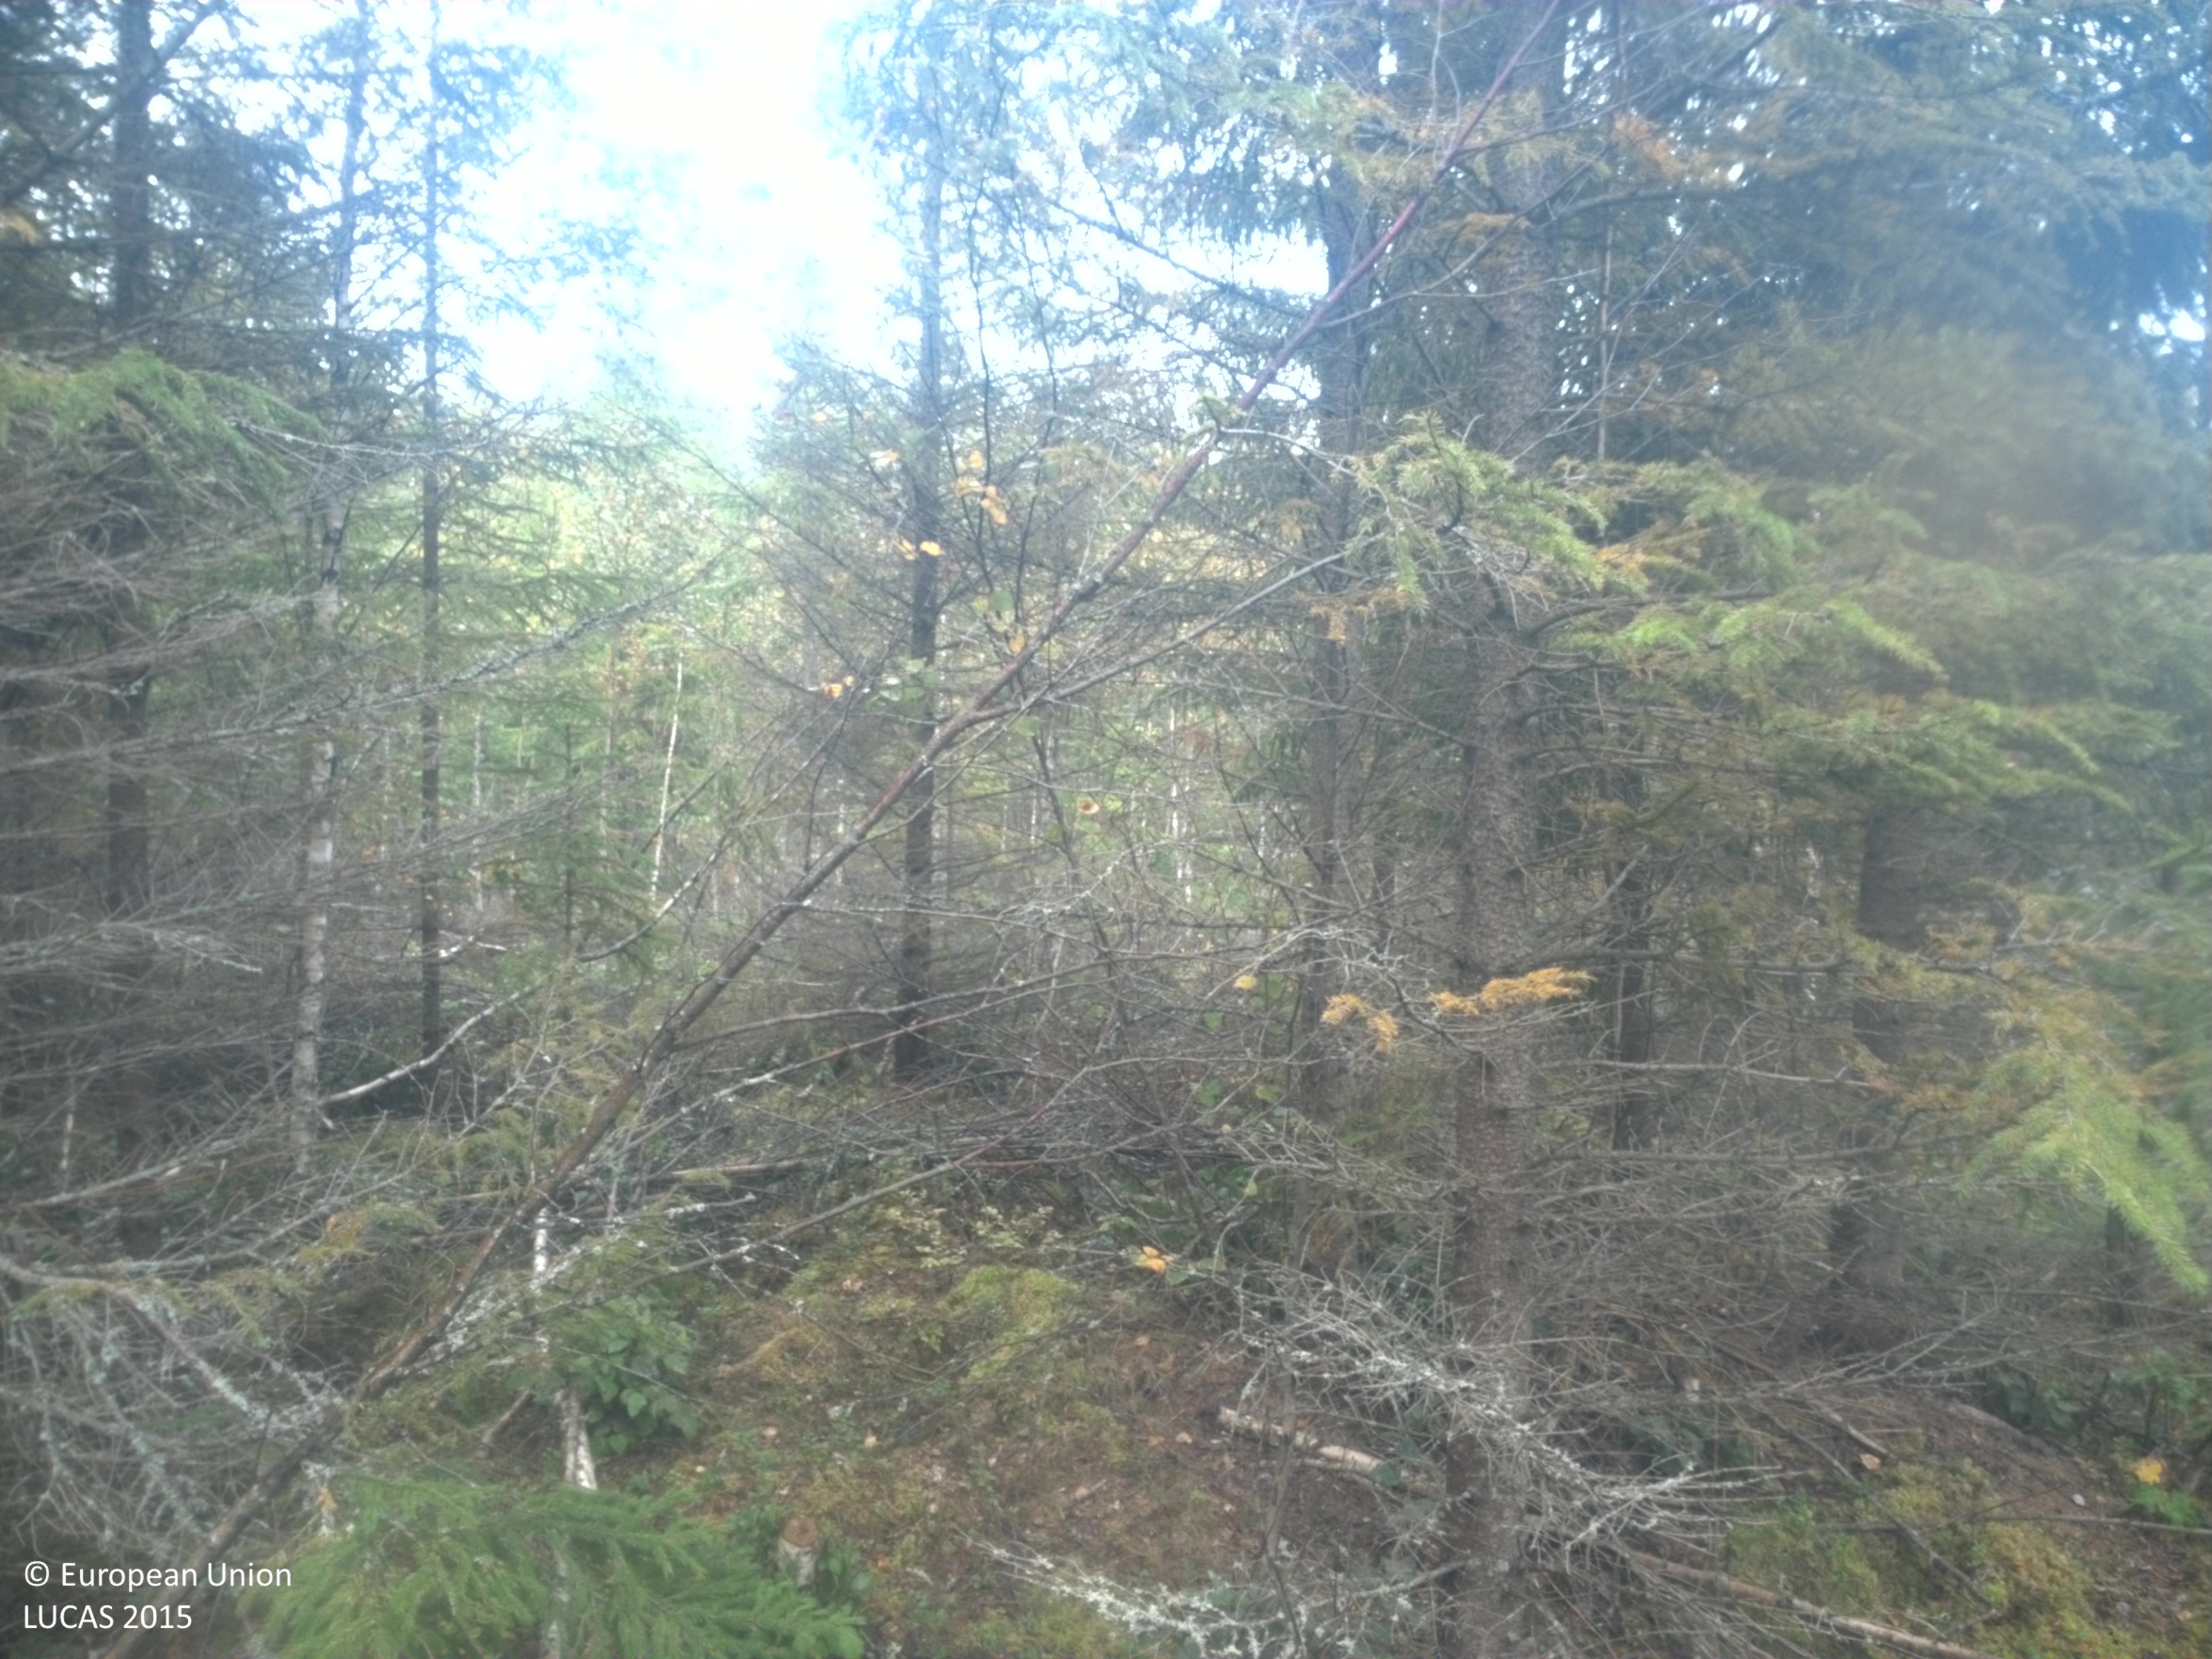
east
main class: Woodland
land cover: Spruce dominated mixed woodland
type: boreal forest
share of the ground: 50 - 75 %
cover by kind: coniferous forest trees 30 %, broadleaved forest trees 20 %, shrubs 20 %, lichens and mosses 20 %, herbaceous plants 10 %
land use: Forestry
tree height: > 5 m
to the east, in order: Spruce dominated mixed woodland; Spruce dominated coniferous woodland; Ditches and canals; Spruce dominated coniferous woodland; Spruce dominated mixed woodland; Spruce dominated coniferous woodland
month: September
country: SE
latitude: 58.8795
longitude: 14.0345
